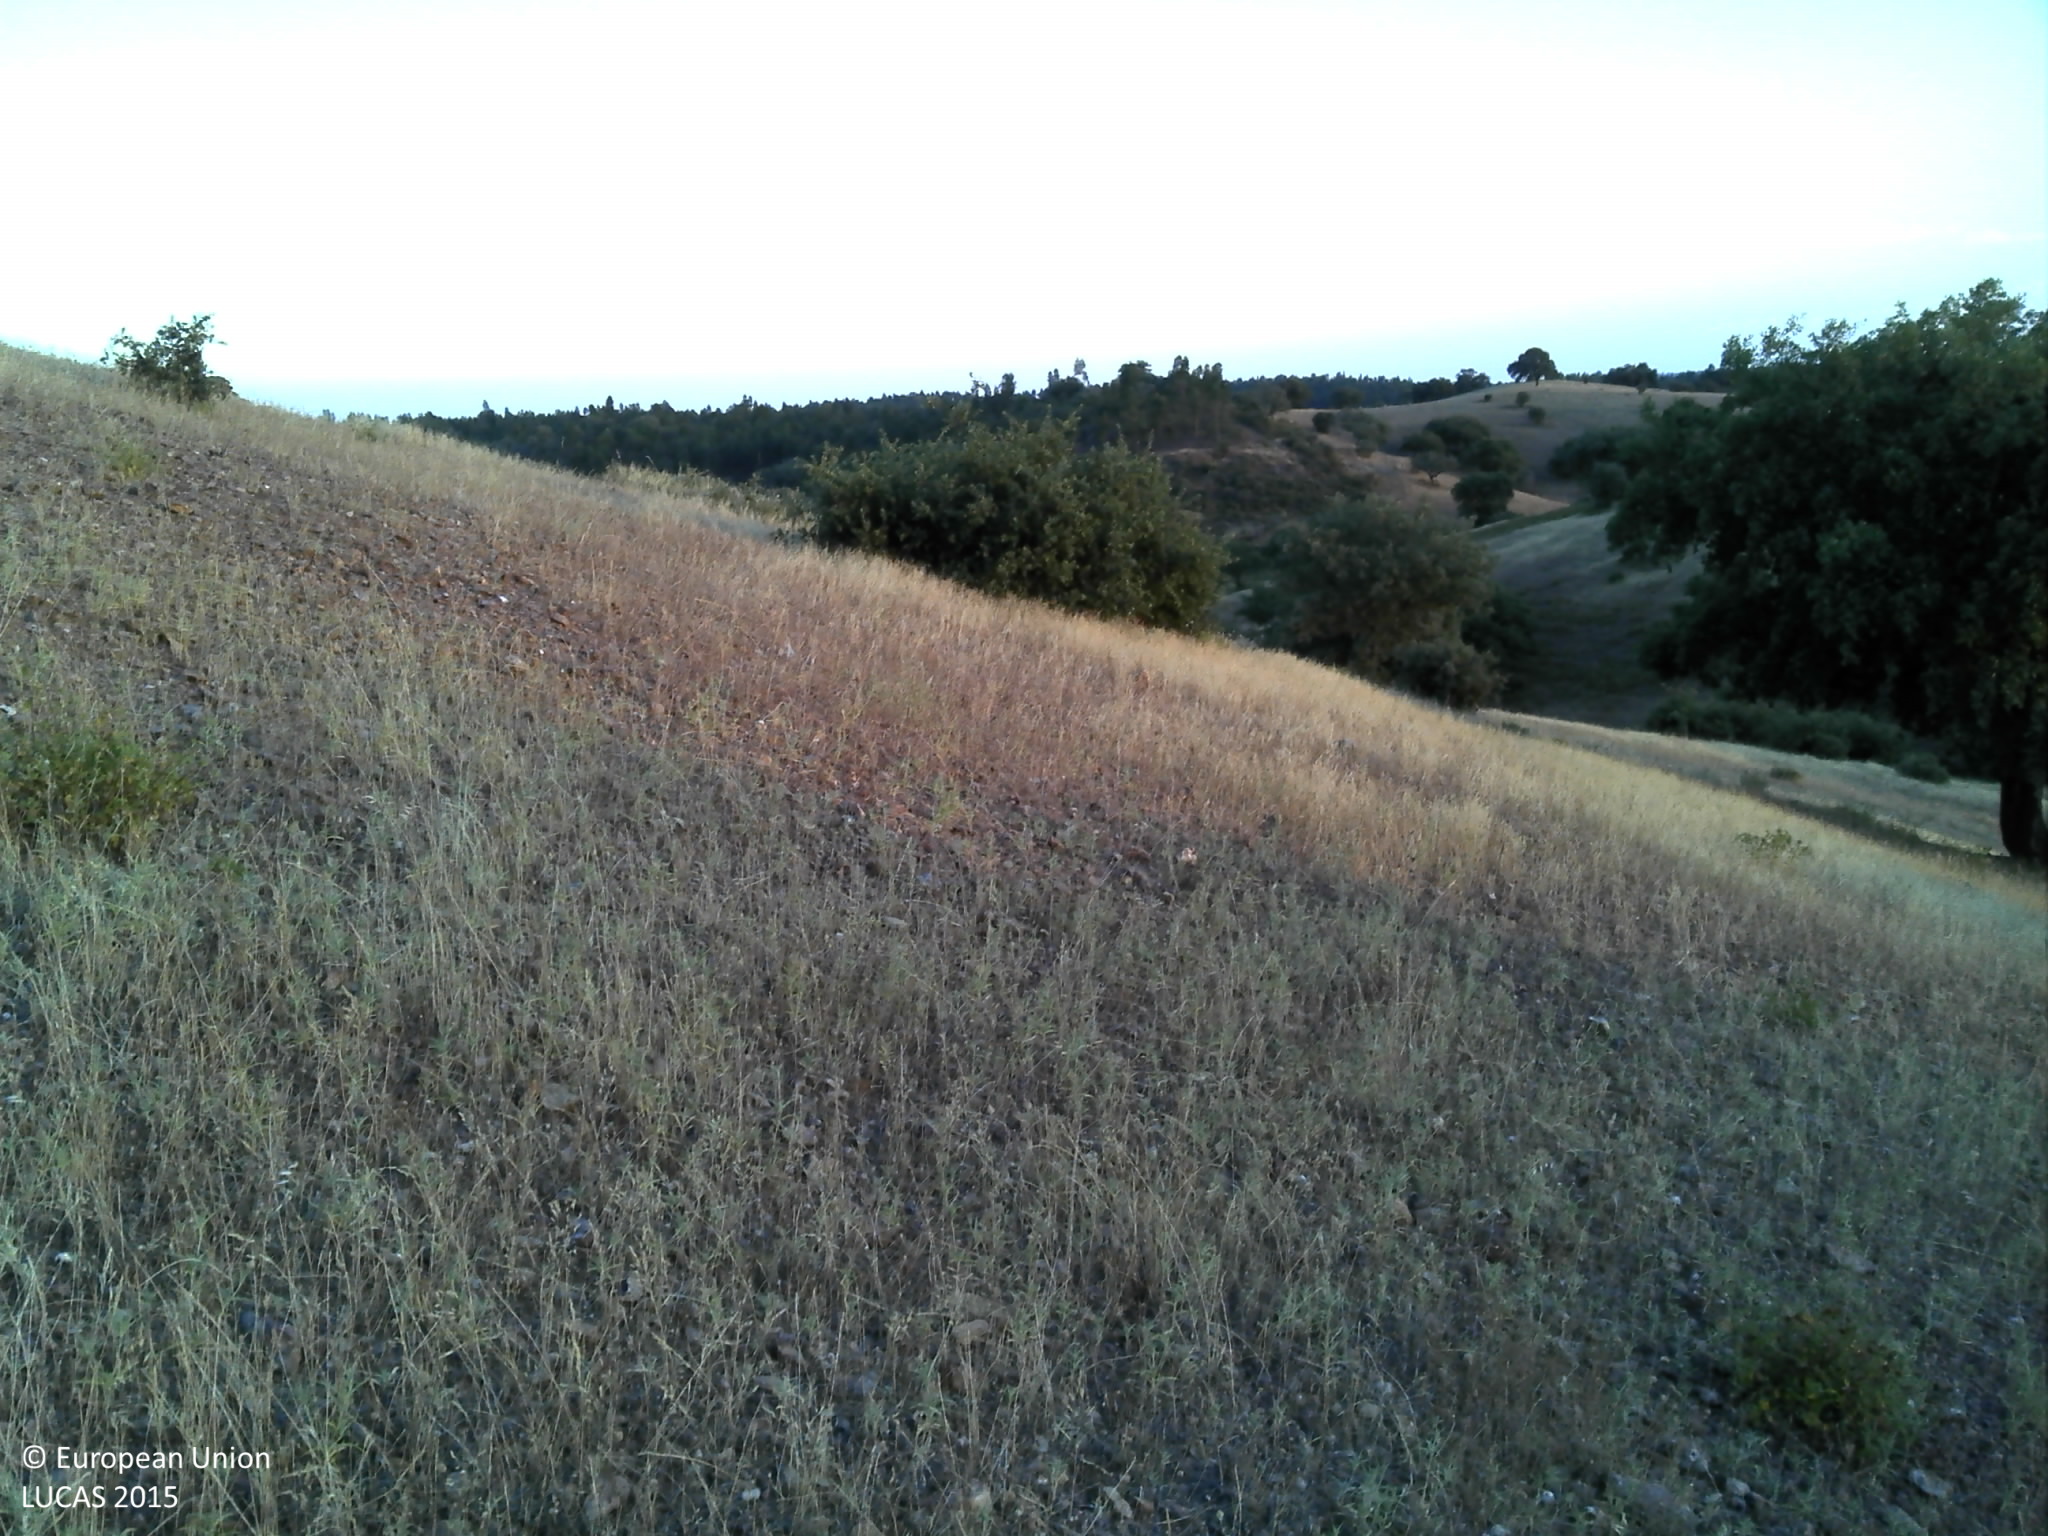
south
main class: Woodland
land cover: Broadleaved woodland
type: broadleaved evergreen forest
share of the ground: 10 - 25 %
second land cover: Grassland without tree/shrub cover
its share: 25 - 50 %
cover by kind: herbaceous plants 50 %, broadleaved forest trees 25 %, unconsolidated bare surface 25 %
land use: Forestry
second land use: Agriculture (excluding fallow land and kitchen gardens)
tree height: > 5 m
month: June
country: PT
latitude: 37.7818
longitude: -7.4658
